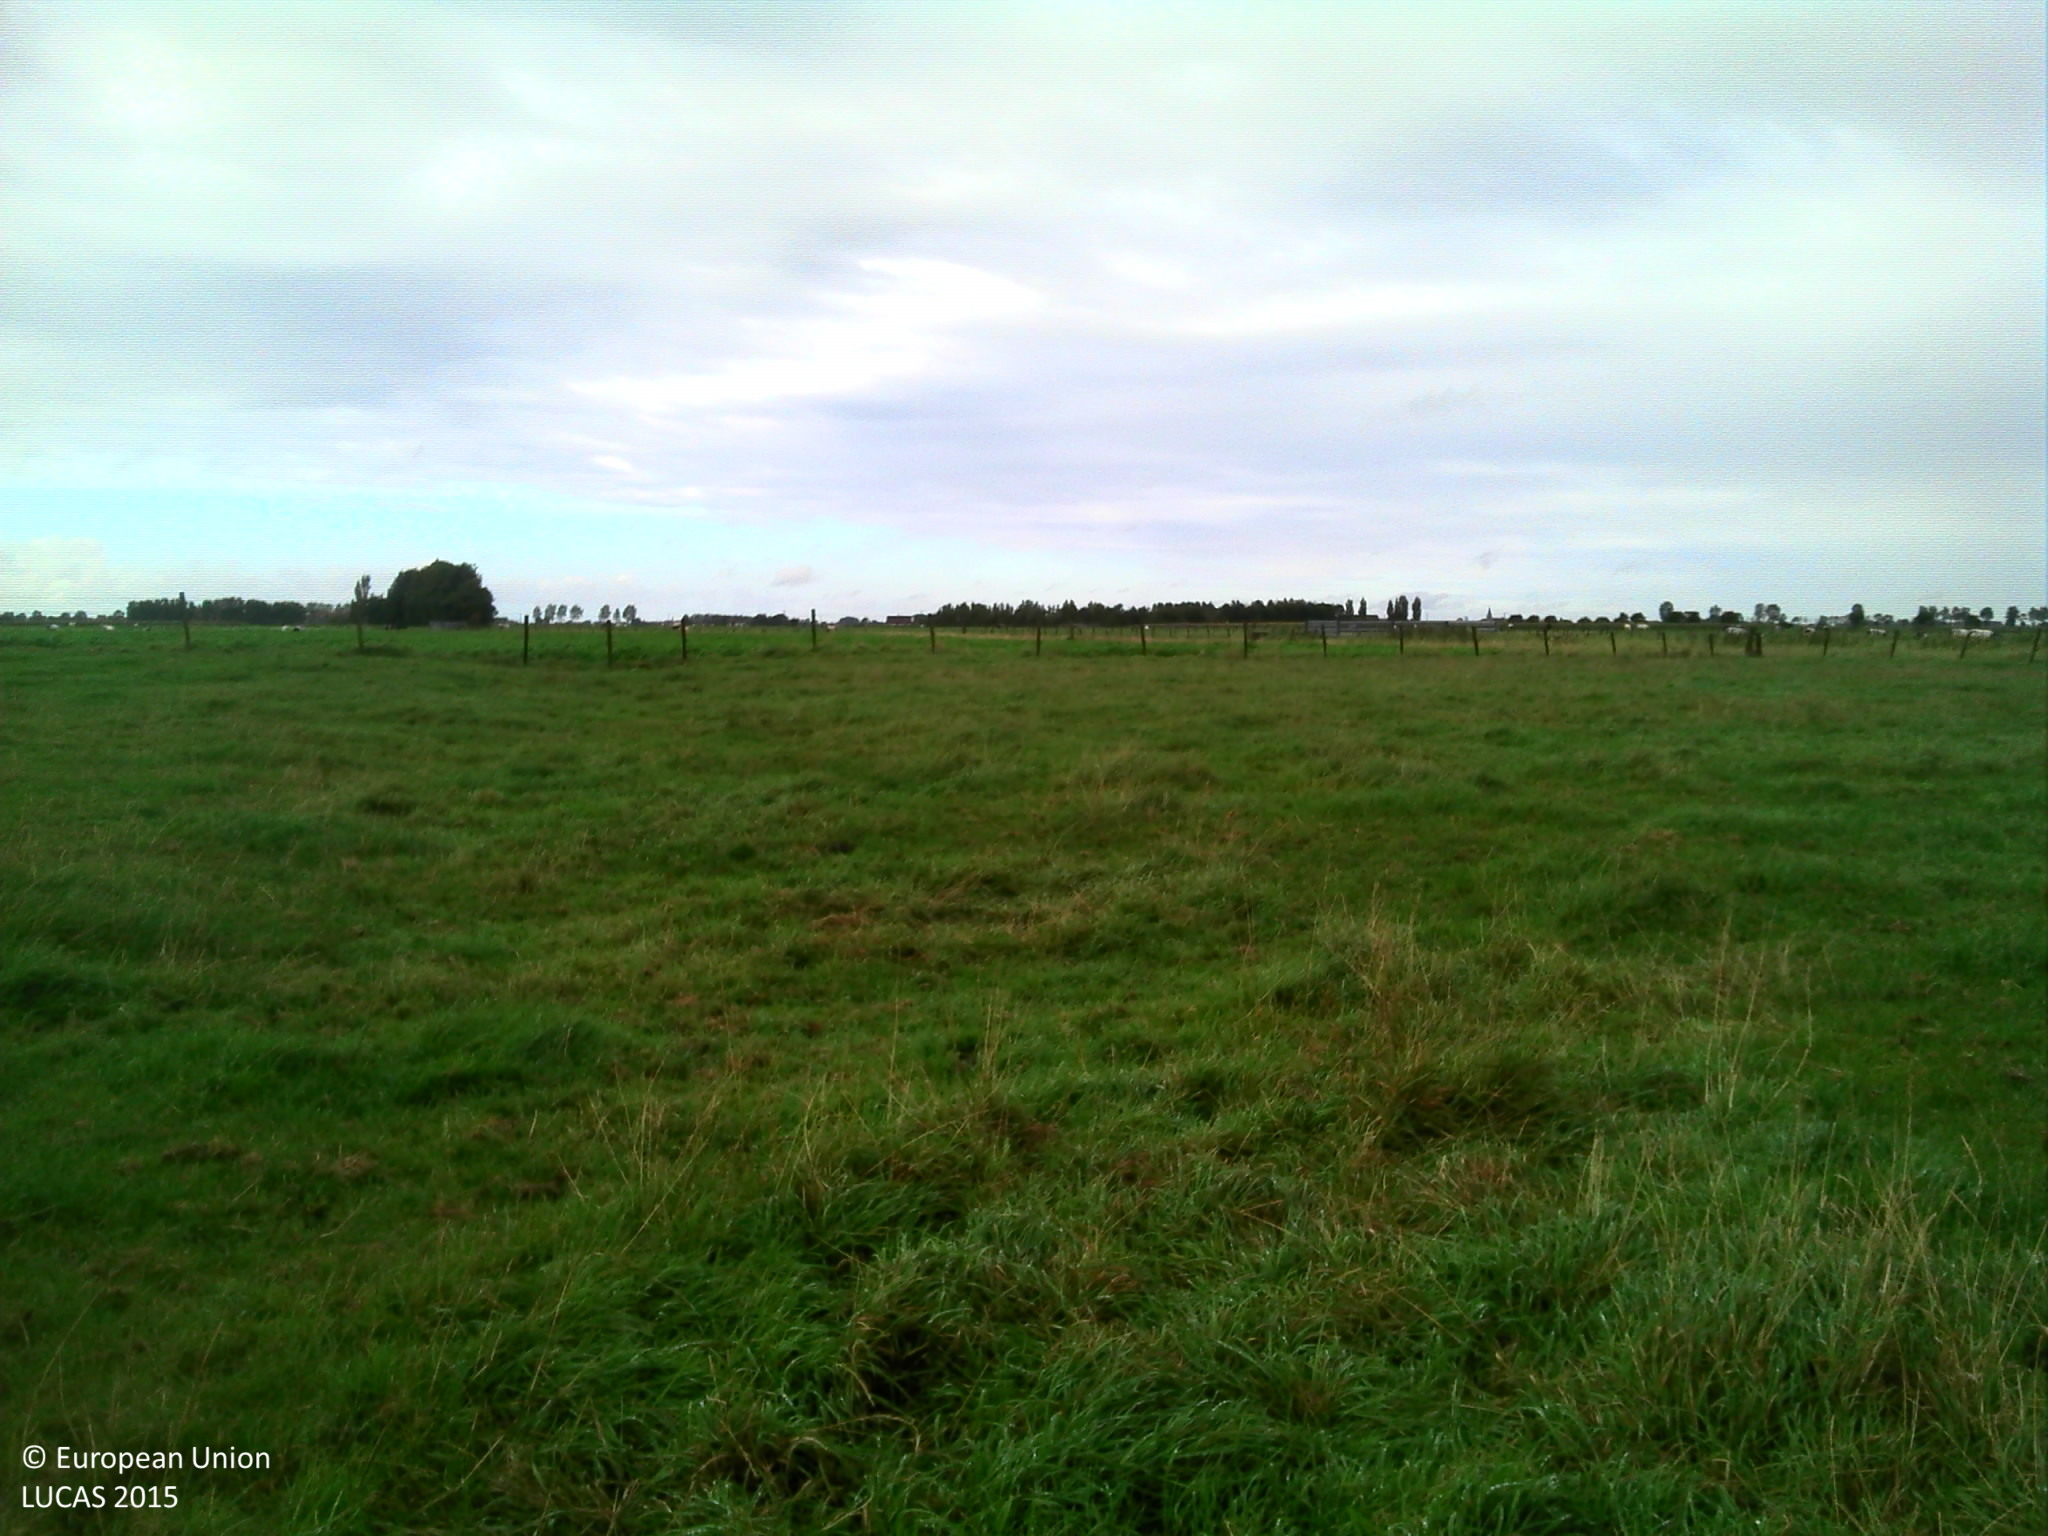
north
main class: Grassland
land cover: Grassland without tree/shrub cover
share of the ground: > 75 %
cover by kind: herbaceous plants 100 %
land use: Agriculture (excluding fallow land and kitchen gardens)
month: September
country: BE
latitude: 51.0978
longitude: 2.8636
